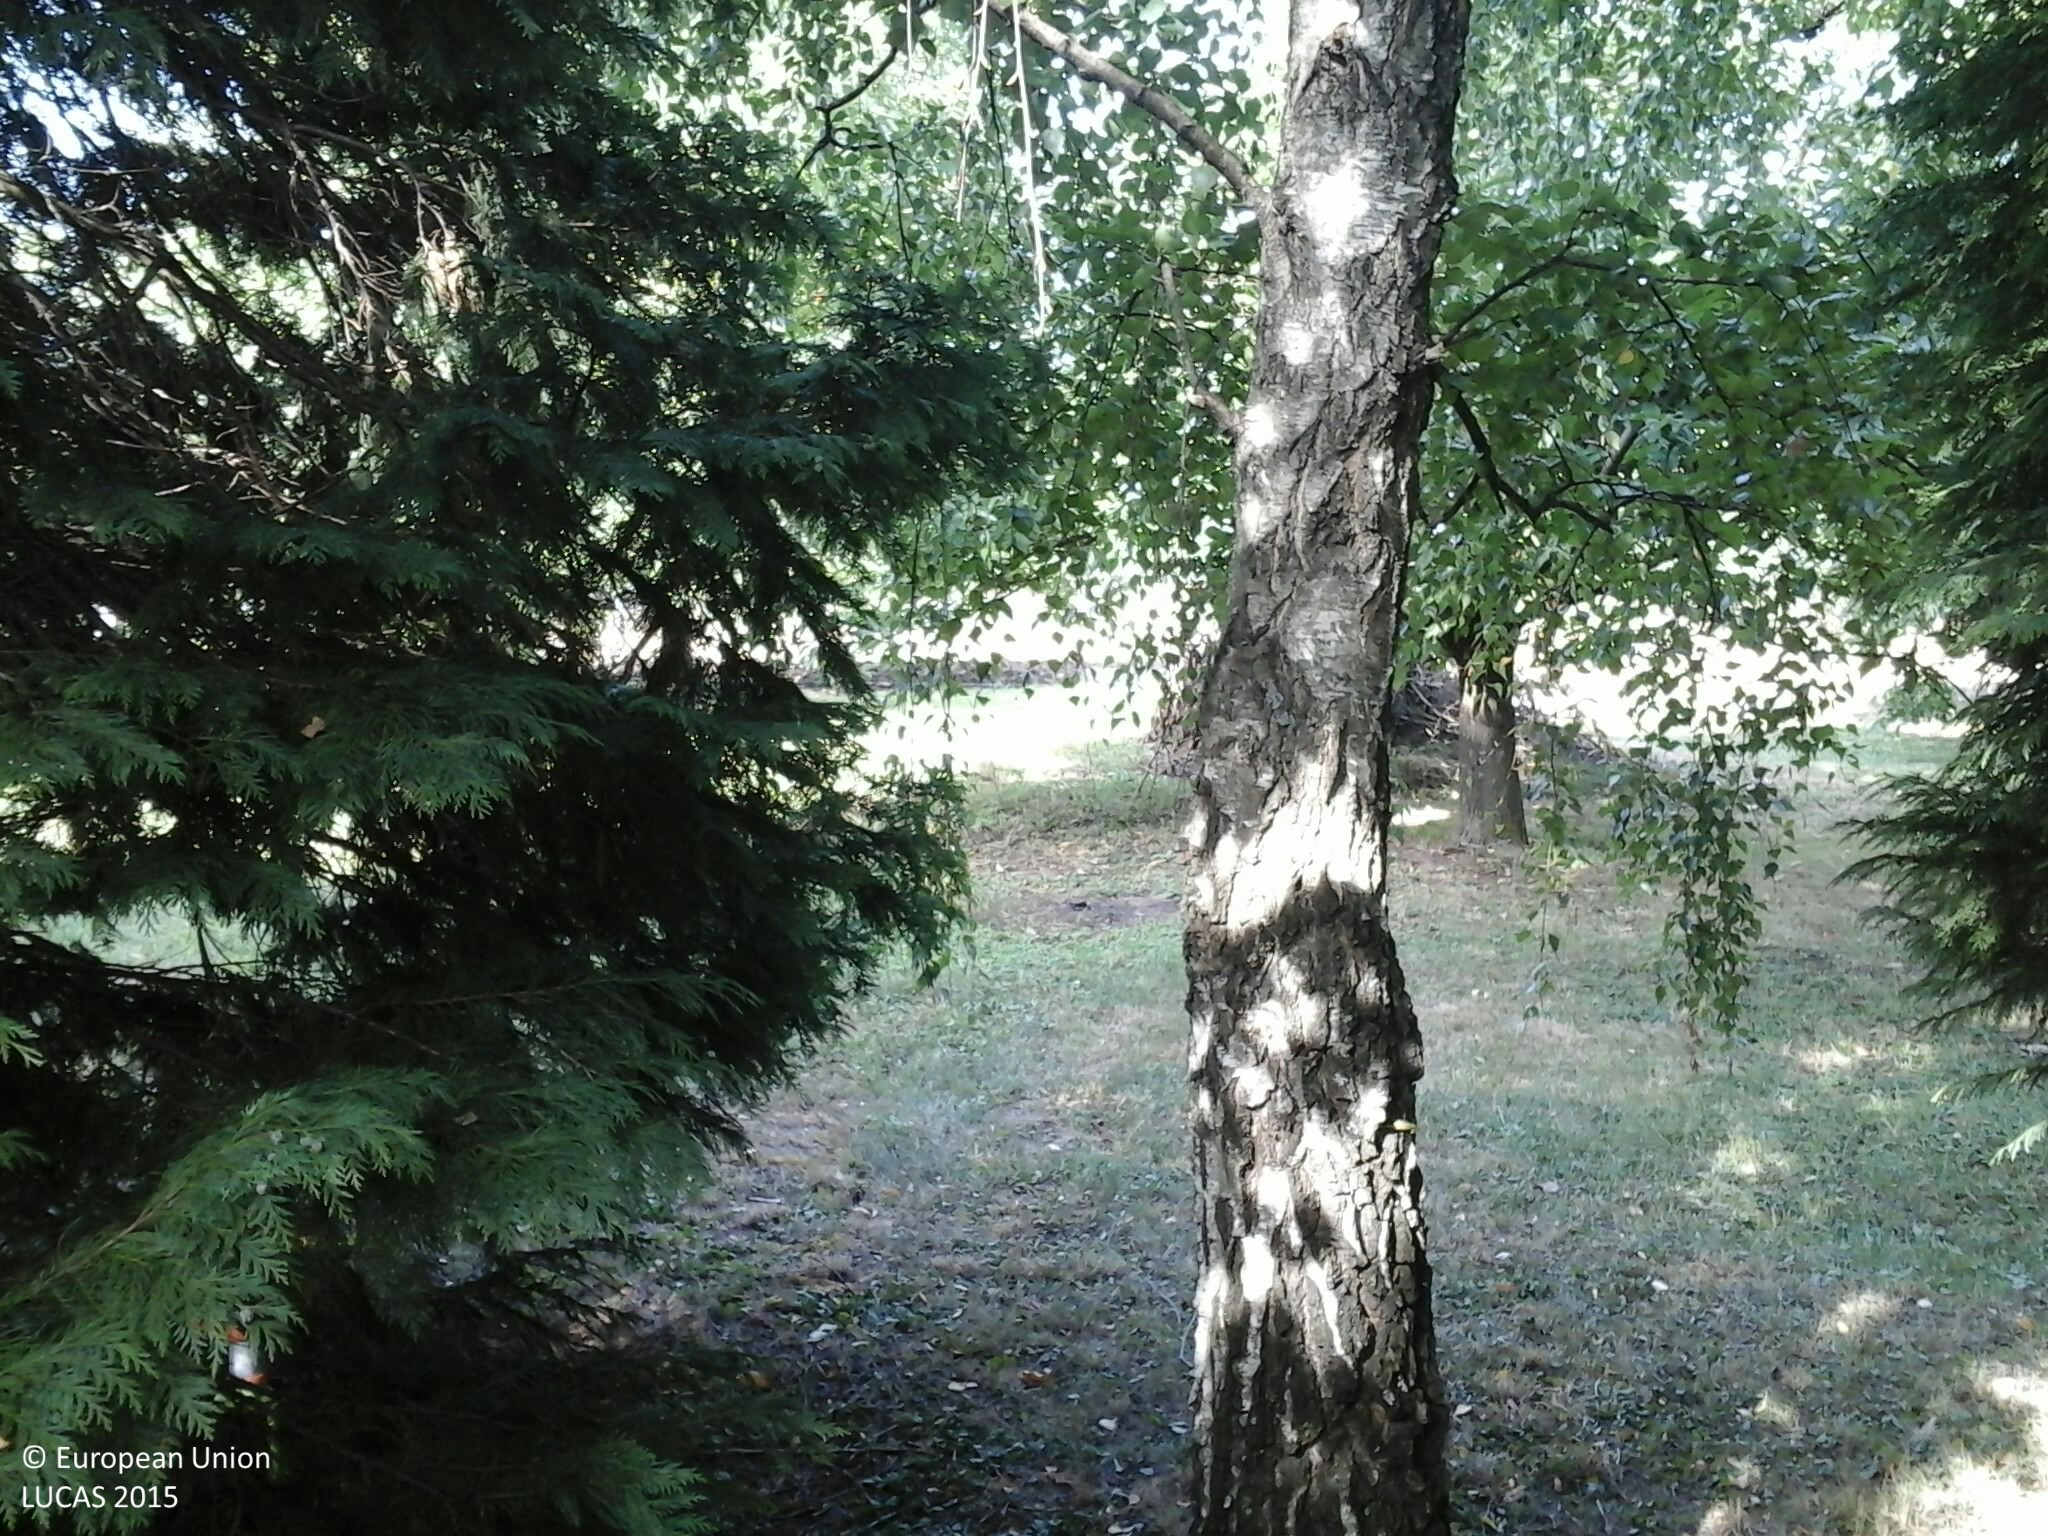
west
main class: Woodland
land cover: Broadleaved woodland
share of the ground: 50 - 75 %
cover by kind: broadleaved forest trees 70 %, herbaceous plants 25 %, coniferous forest trees 5 %
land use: Community services
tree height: > 5 m
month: August
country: HU
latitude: 46.8862
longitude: 16.6299
